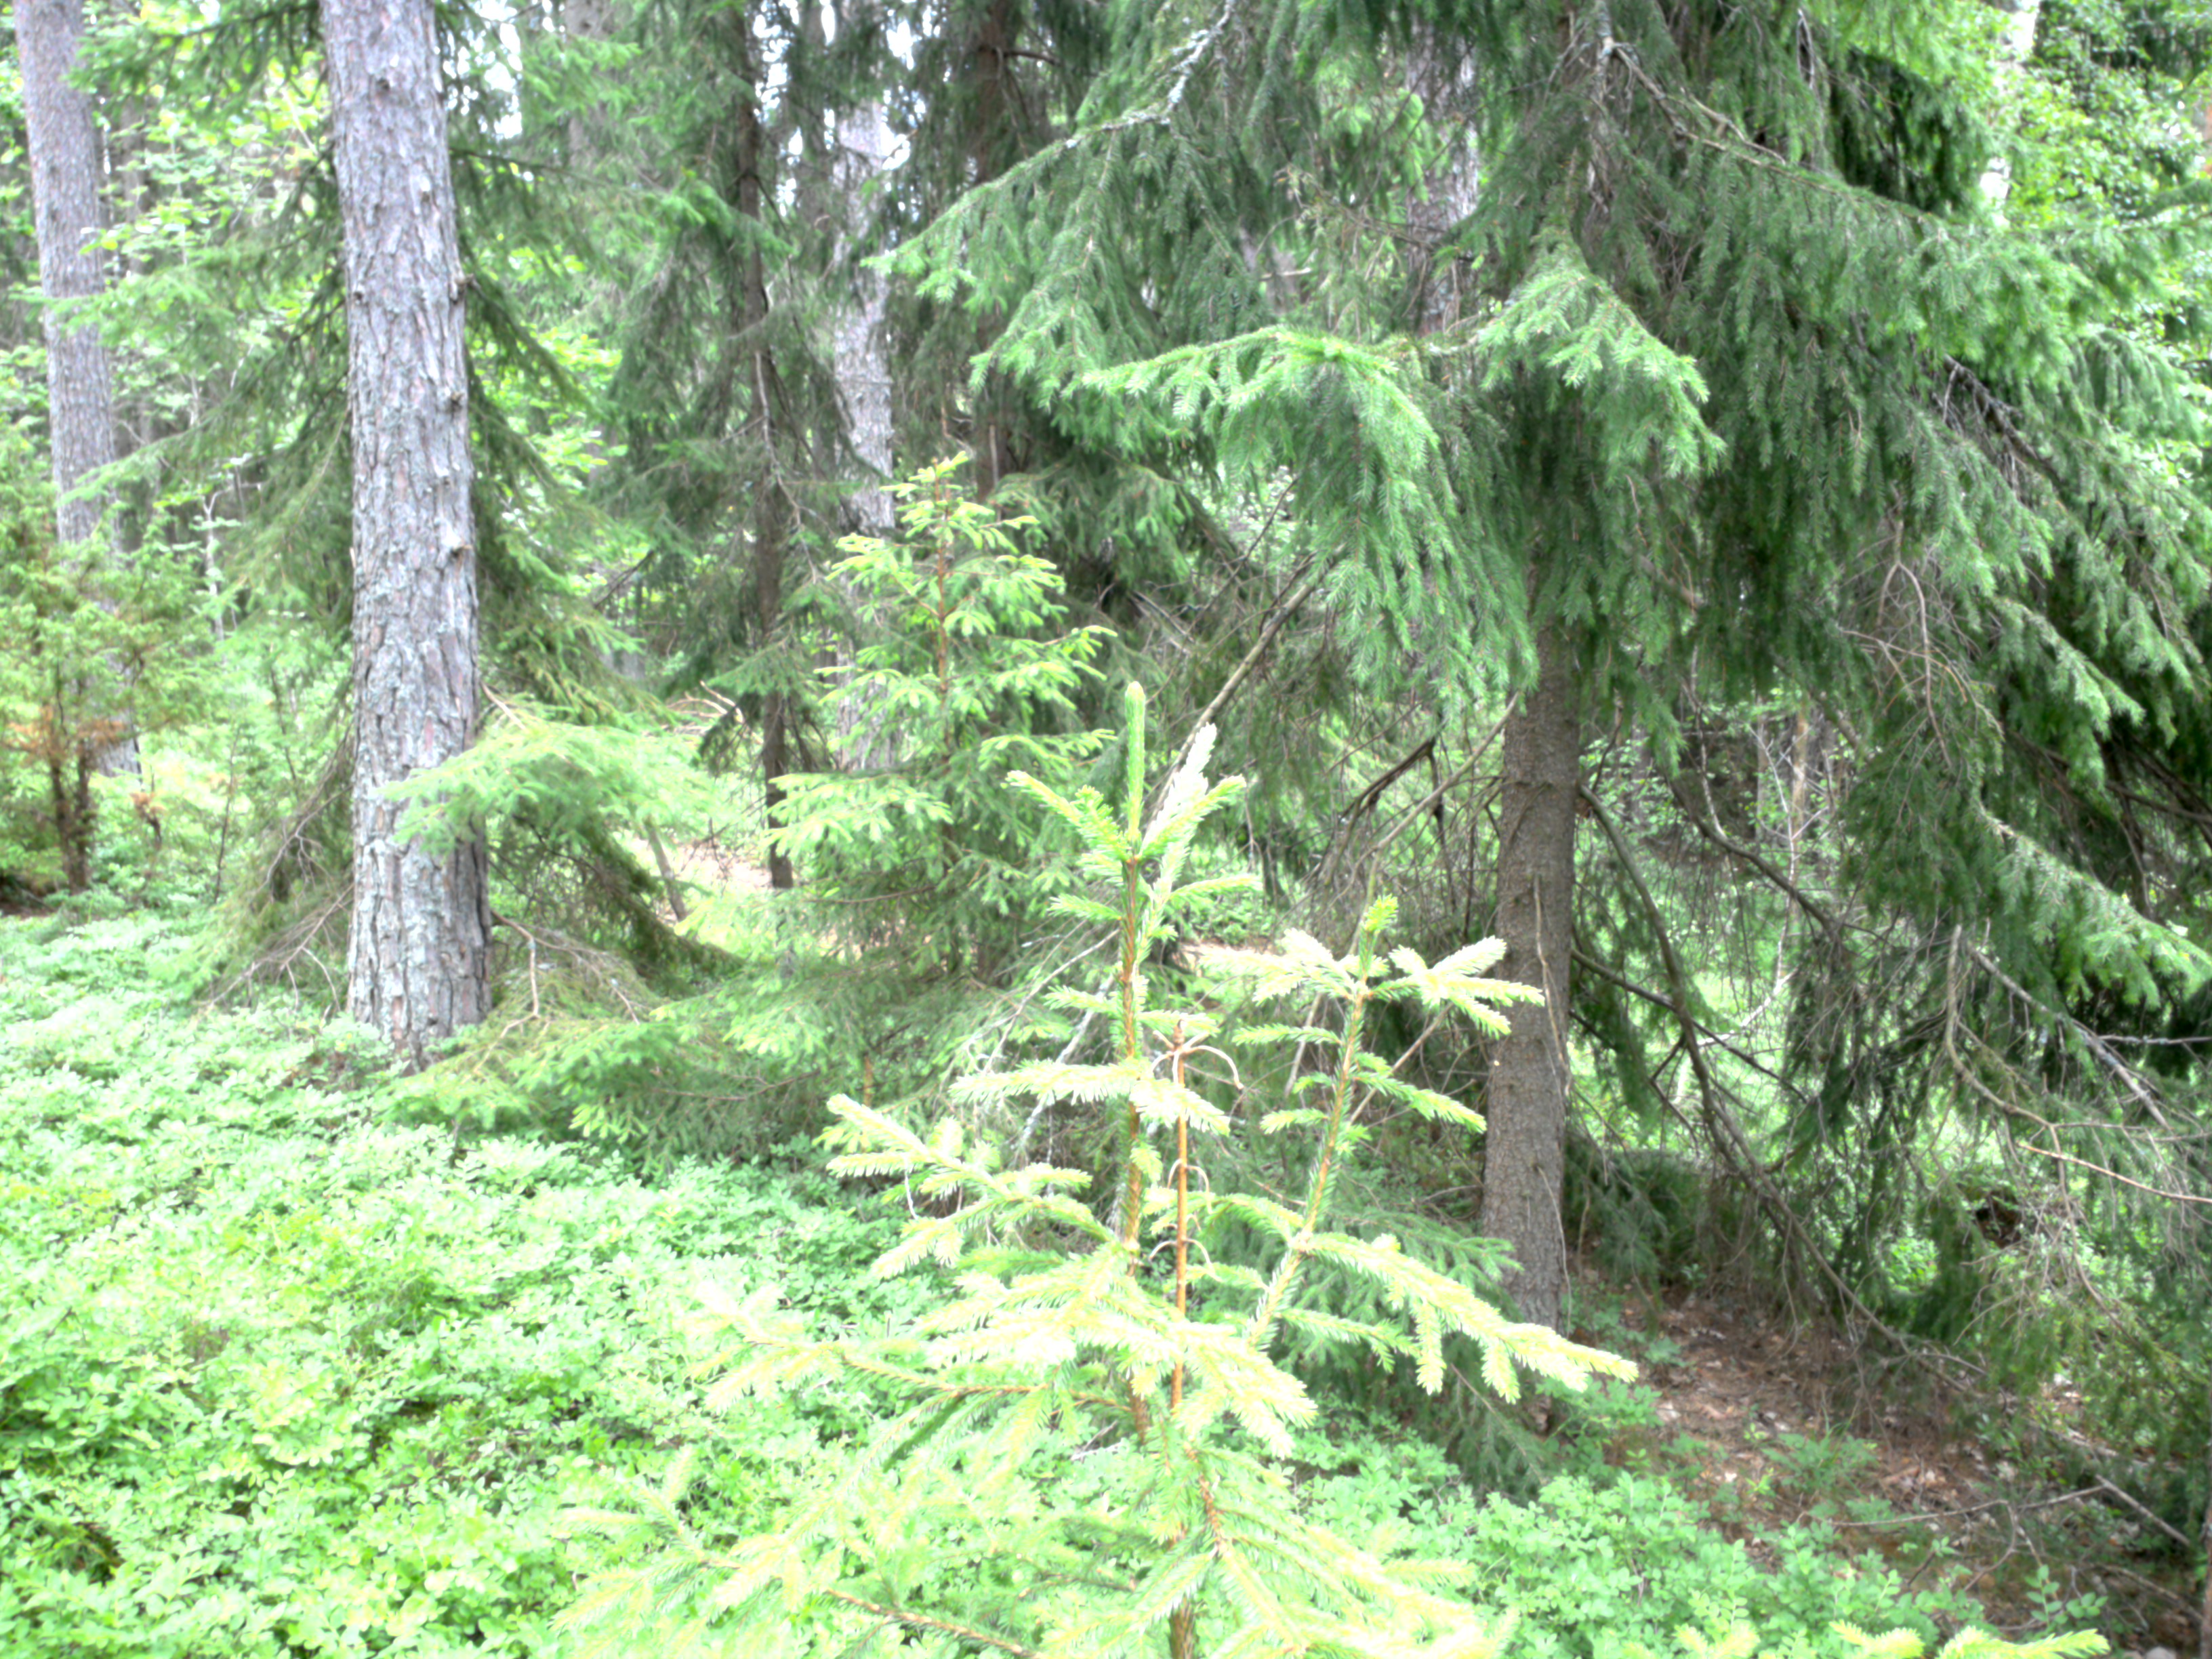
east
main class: Woodland
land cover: Pine dominated coniferous woodland
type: boreal forest
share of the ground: 50 - 75 %
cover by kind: coniferous forest trees 70 %, shrubs 25 %, herbaceous plants 5 %
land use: Forestry
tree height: > 5 m
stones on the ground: < 10 %
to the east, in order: Pine dominated coniferous woodland; Tracks; Spruce dominated coniferous woodland; Pine dominated coniferous woodland
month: June
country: SE
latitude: 59.2563
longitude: 17.5204
